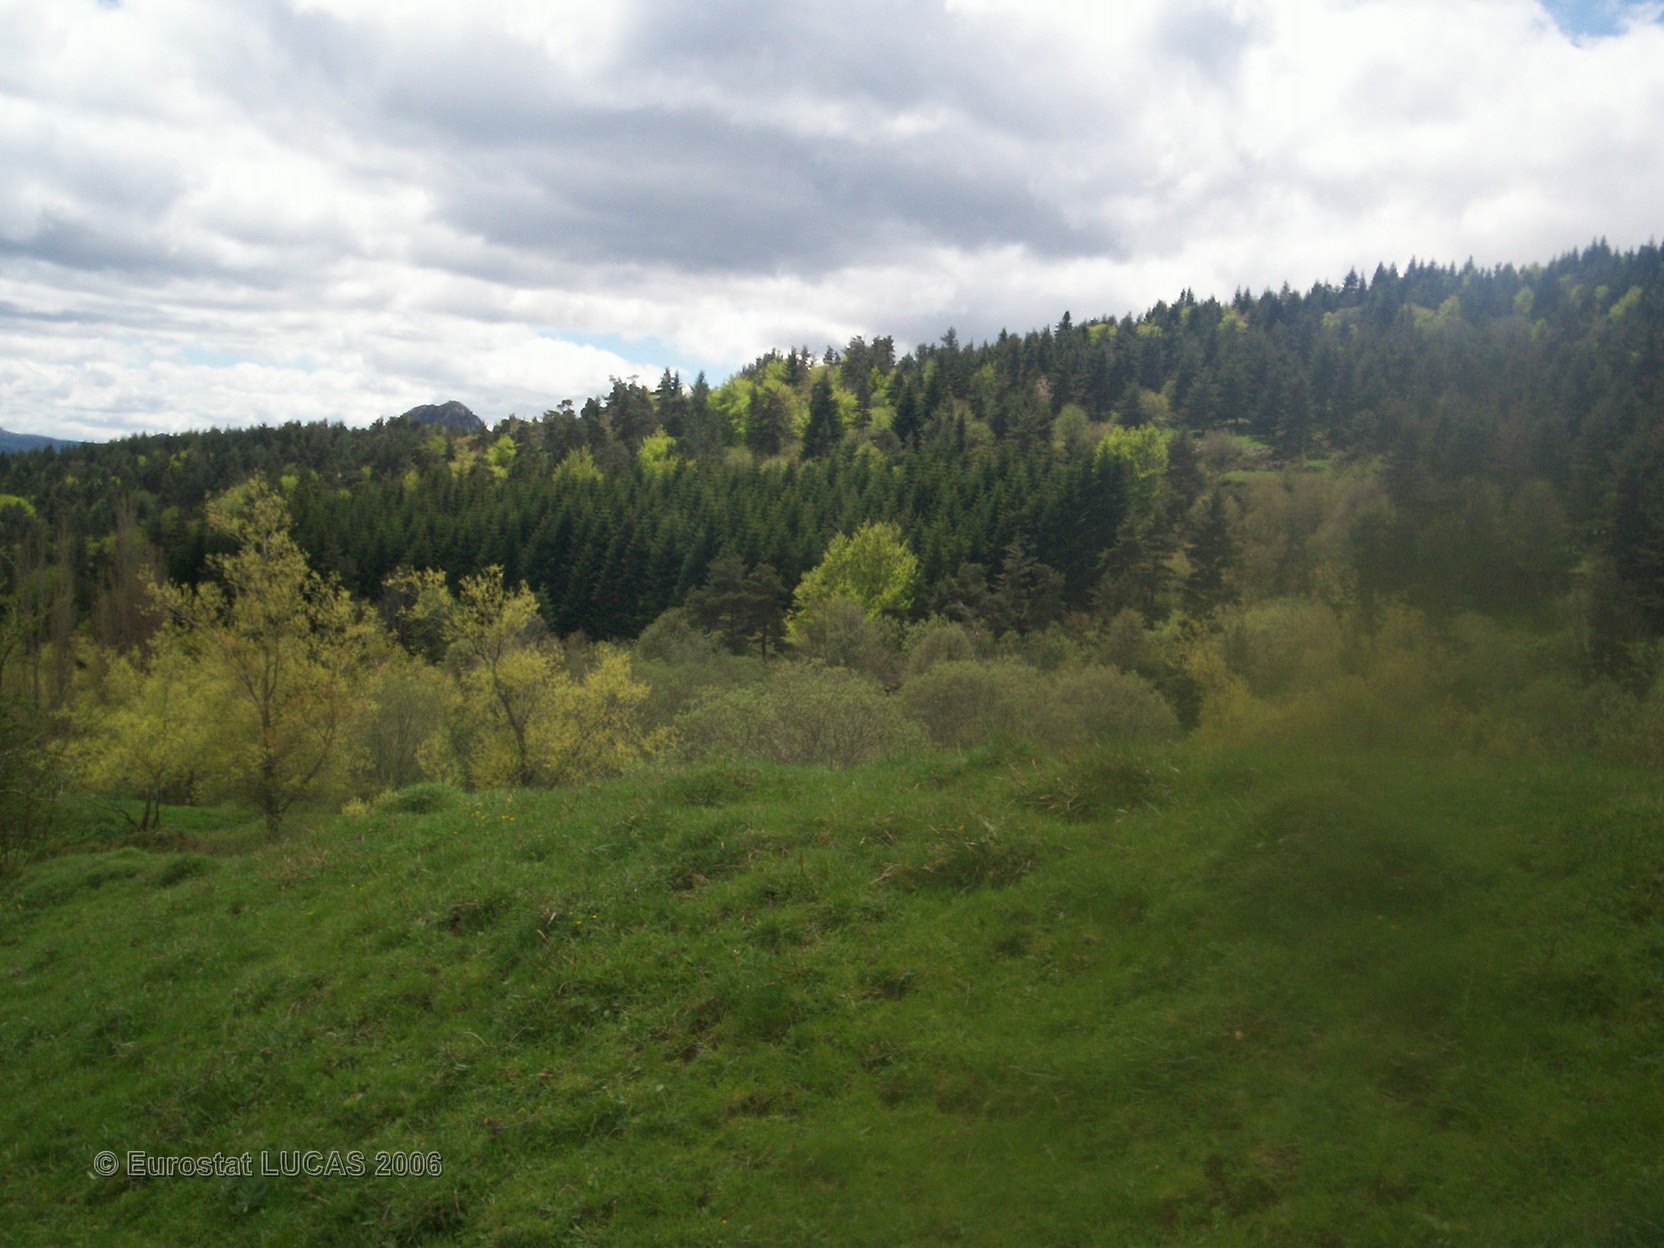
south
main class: Grassland
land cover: Grassland without tree/shrub cover
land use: Agriculture (excluding fallow land and kitchen gardens)
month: May
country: FR
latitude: 44.9122
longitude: 4.2165
